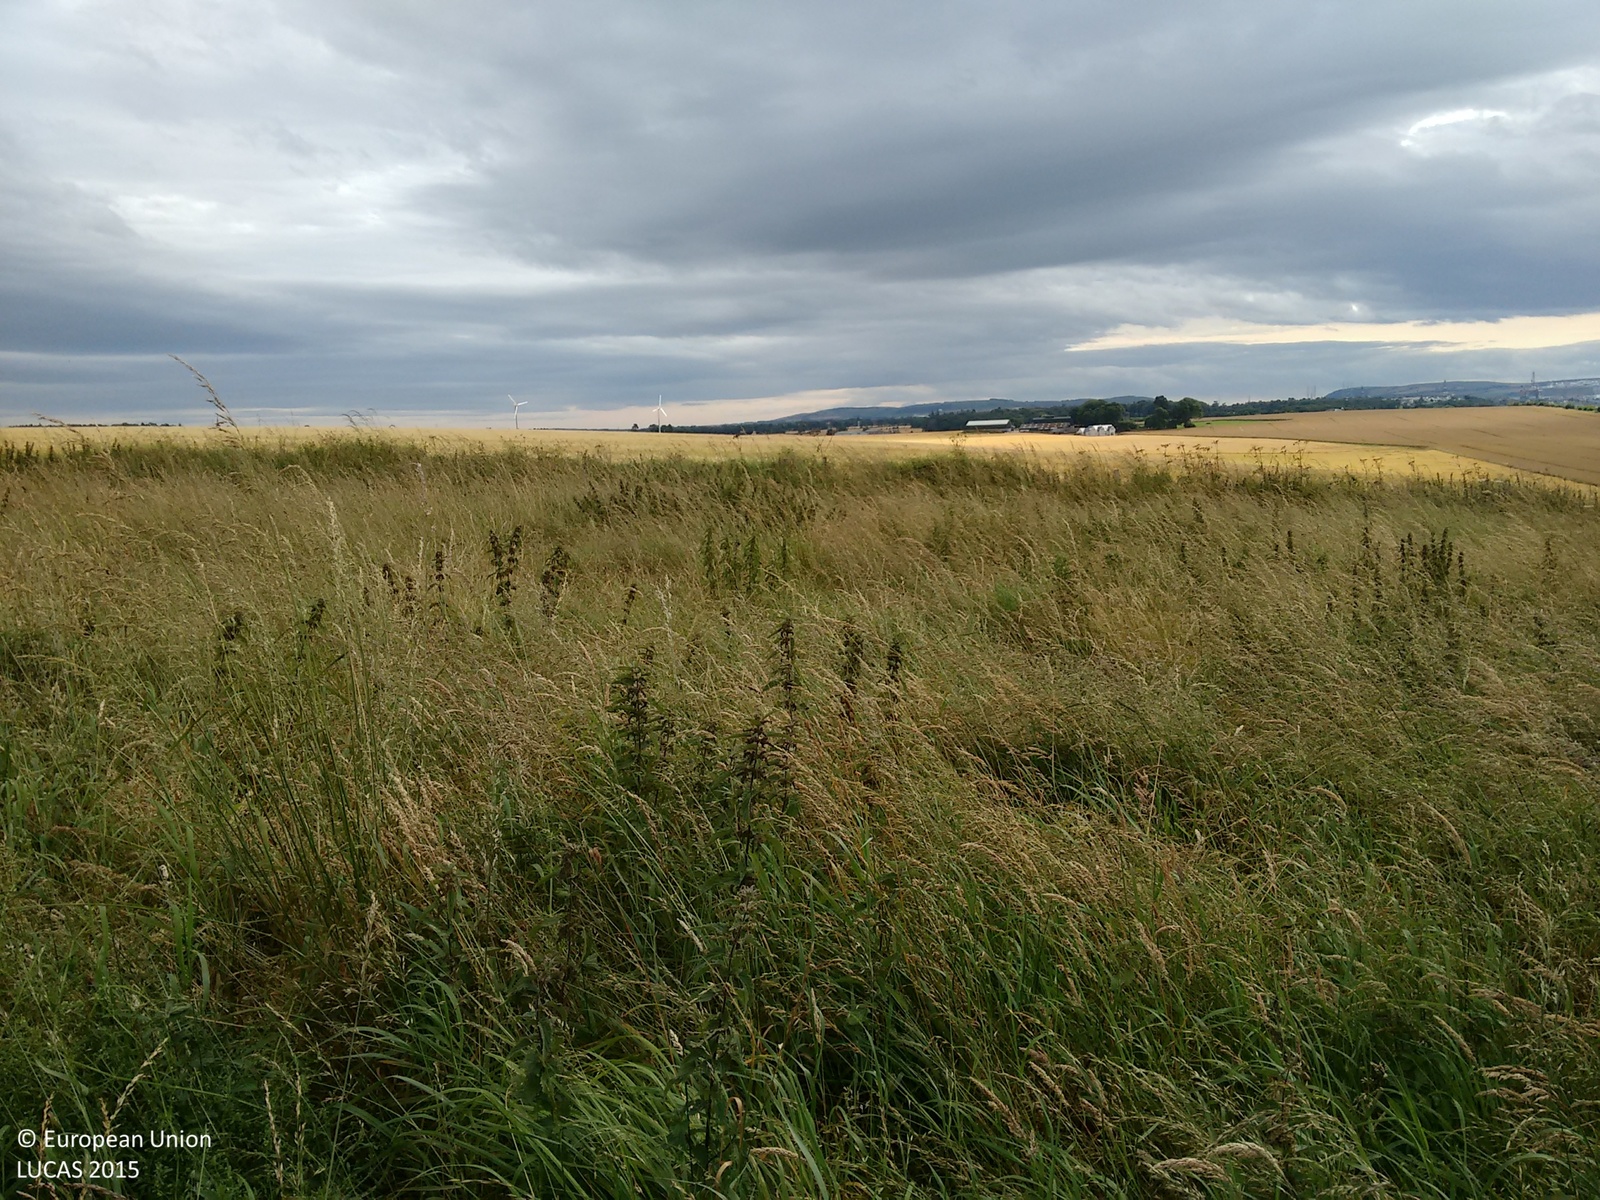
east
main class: Cropland
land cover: Barley
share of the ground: > 75 %
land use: Agriculture (excluding fallow land and kitchen gardens)
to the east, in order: Barley; Grassland without tree/shrub cover; Dry stone walls; Barley
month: August
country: GB
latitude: 57.6952
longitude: -4.2269
